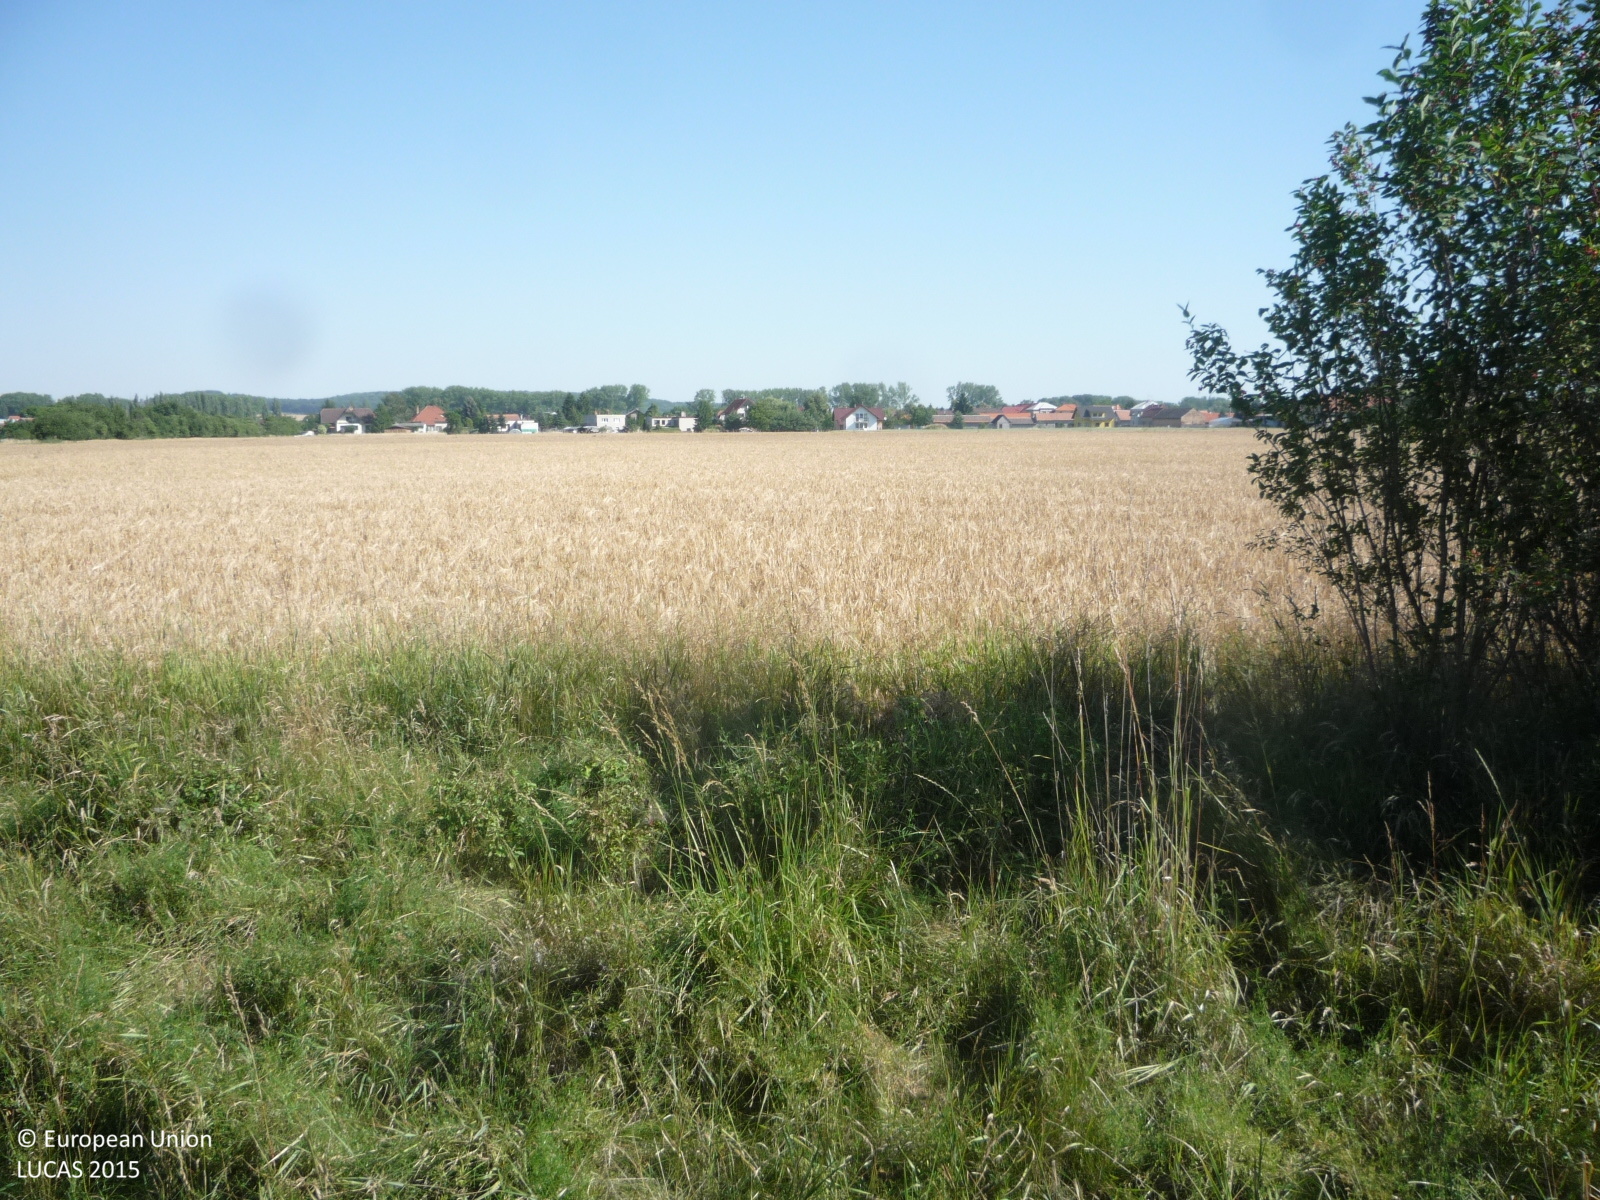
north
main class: Shrubland
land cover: Shrubland with sparse tree cover
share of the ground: > 75 %
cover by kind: shrubs 50 %, herbaceous plants 45 %, broadleaved forest trees 5 %
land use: Agriculture (excluding fallow land and kitchen gardens)
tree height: < 5 m
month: July
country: CZ
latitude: 50.1175
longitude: 15.2479
